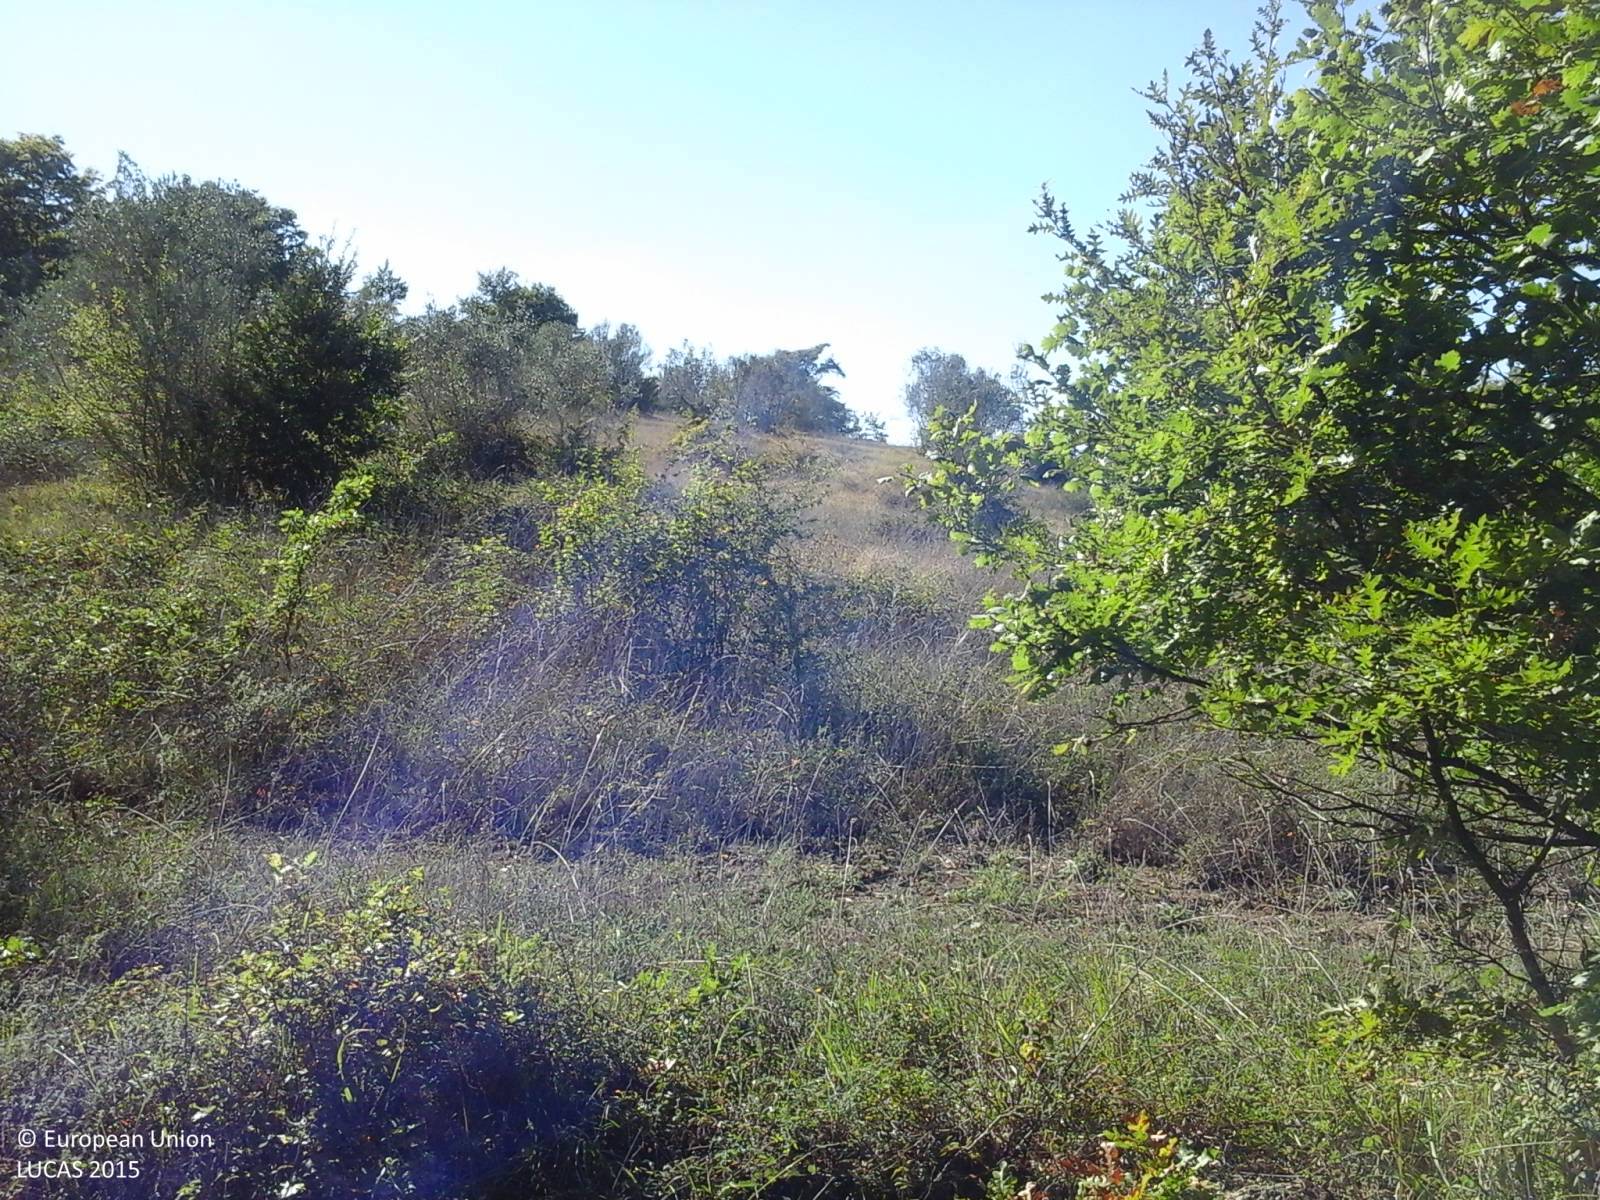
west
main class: Woodland
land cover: Broadleaved woodland
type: thermophilous deciduous forest
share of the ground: > 75 %
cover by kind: broadleaved forest trees 90 %, shrubs 10 %
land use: Forestry
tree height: > 5 m
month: September
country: IT
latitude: 42.7610
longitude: 11.9854
